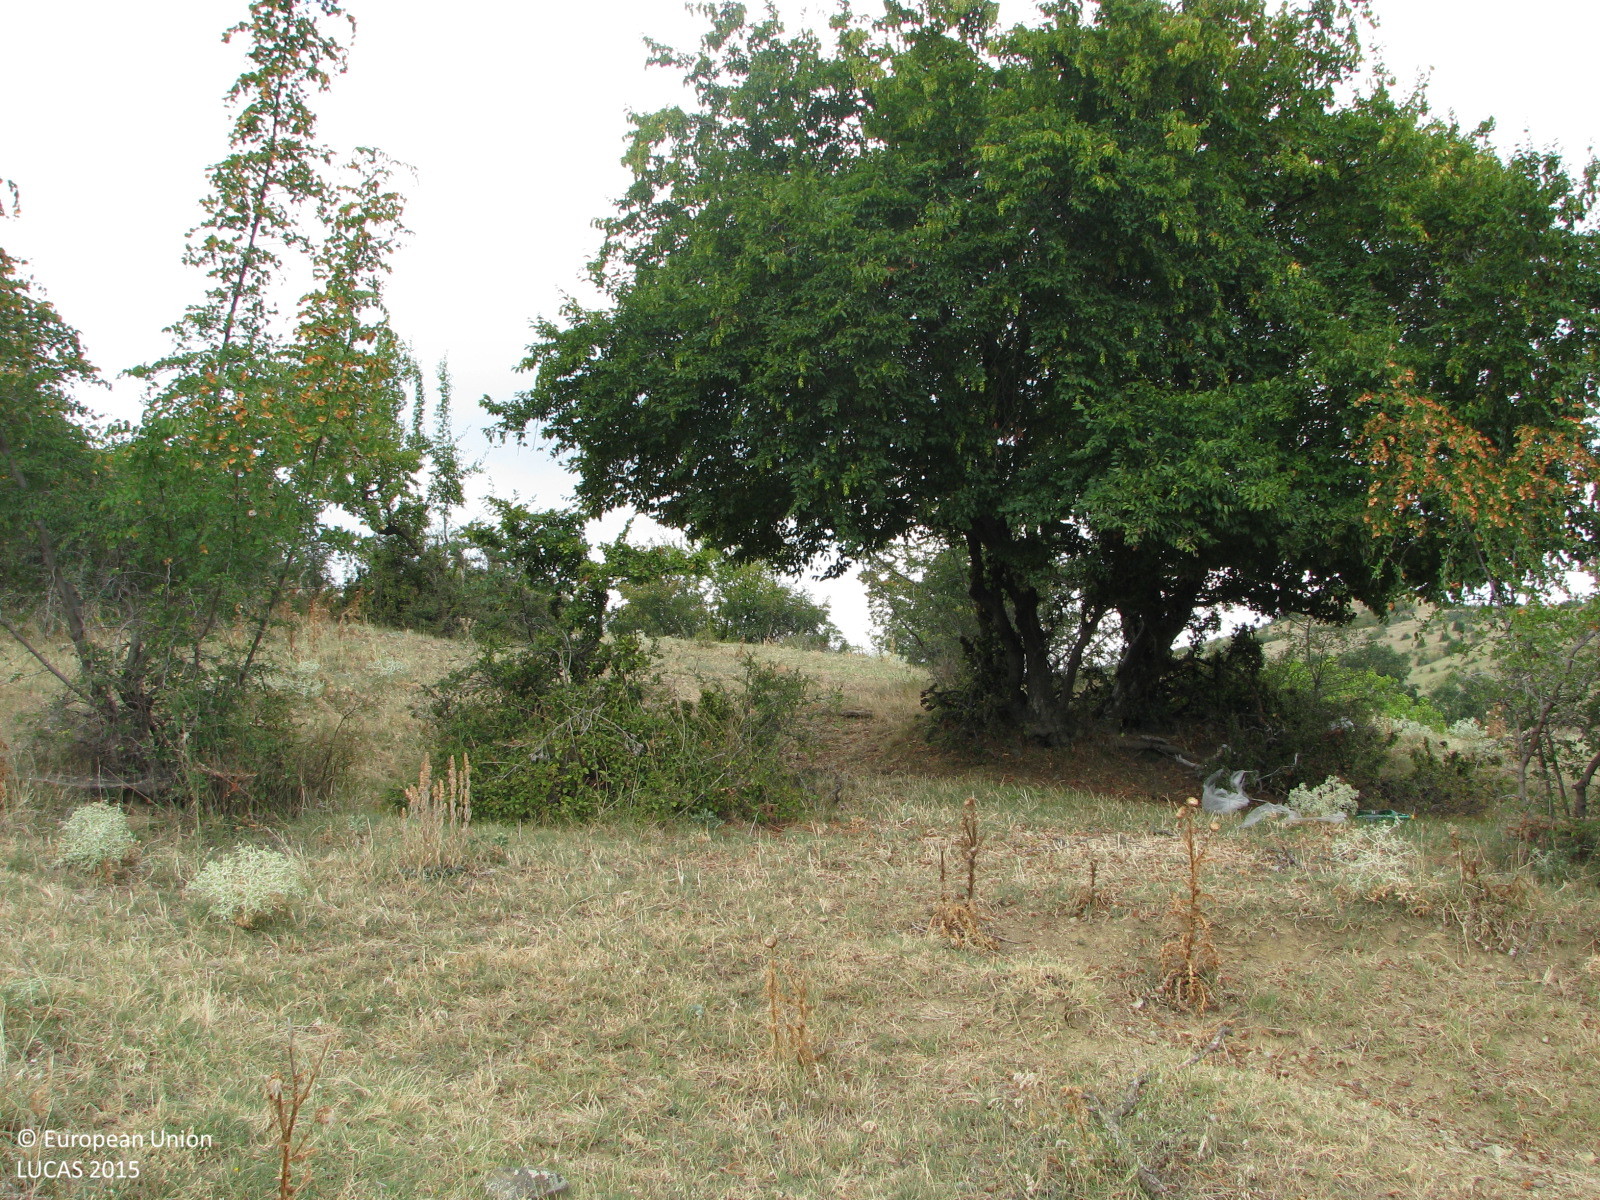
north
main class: Grassland
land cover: Grassland with sparse tree/shrub cover
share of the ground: > 75 %
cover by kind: herbaceous plants 85 %, shrubs 10 %, broadleaved forest trees 5 %
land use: Agriculture (excluding fallow land and kitchen gardens)
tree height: < 5 m
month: August
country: BG
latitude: 42.5525
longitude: 25.9741
